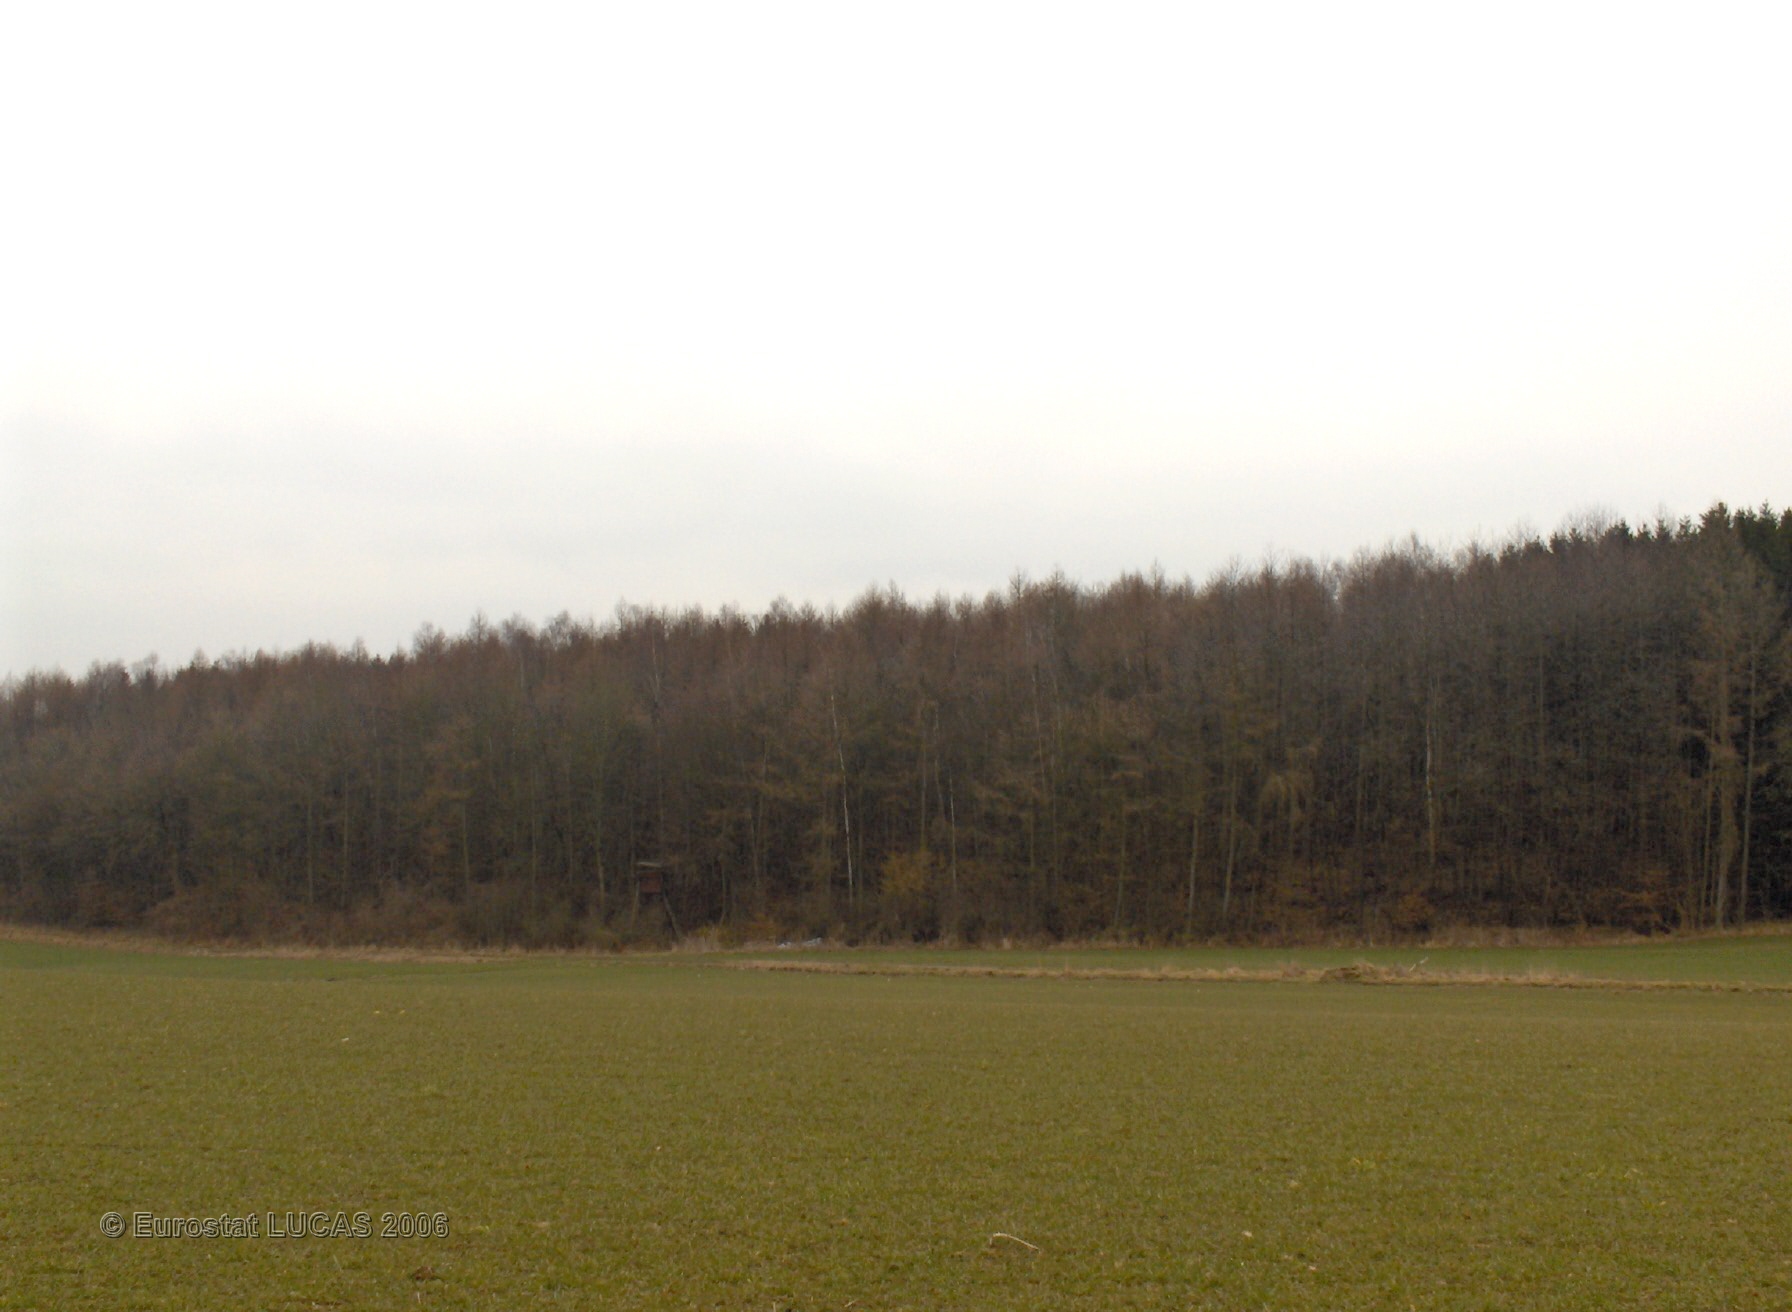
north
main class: Grassland
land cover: Grassland without tree/shrub cover
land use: Agriculture (excluding fallow land and kitchen gardens)
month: March
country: BE
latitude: 50.4827
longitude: 5.2766
